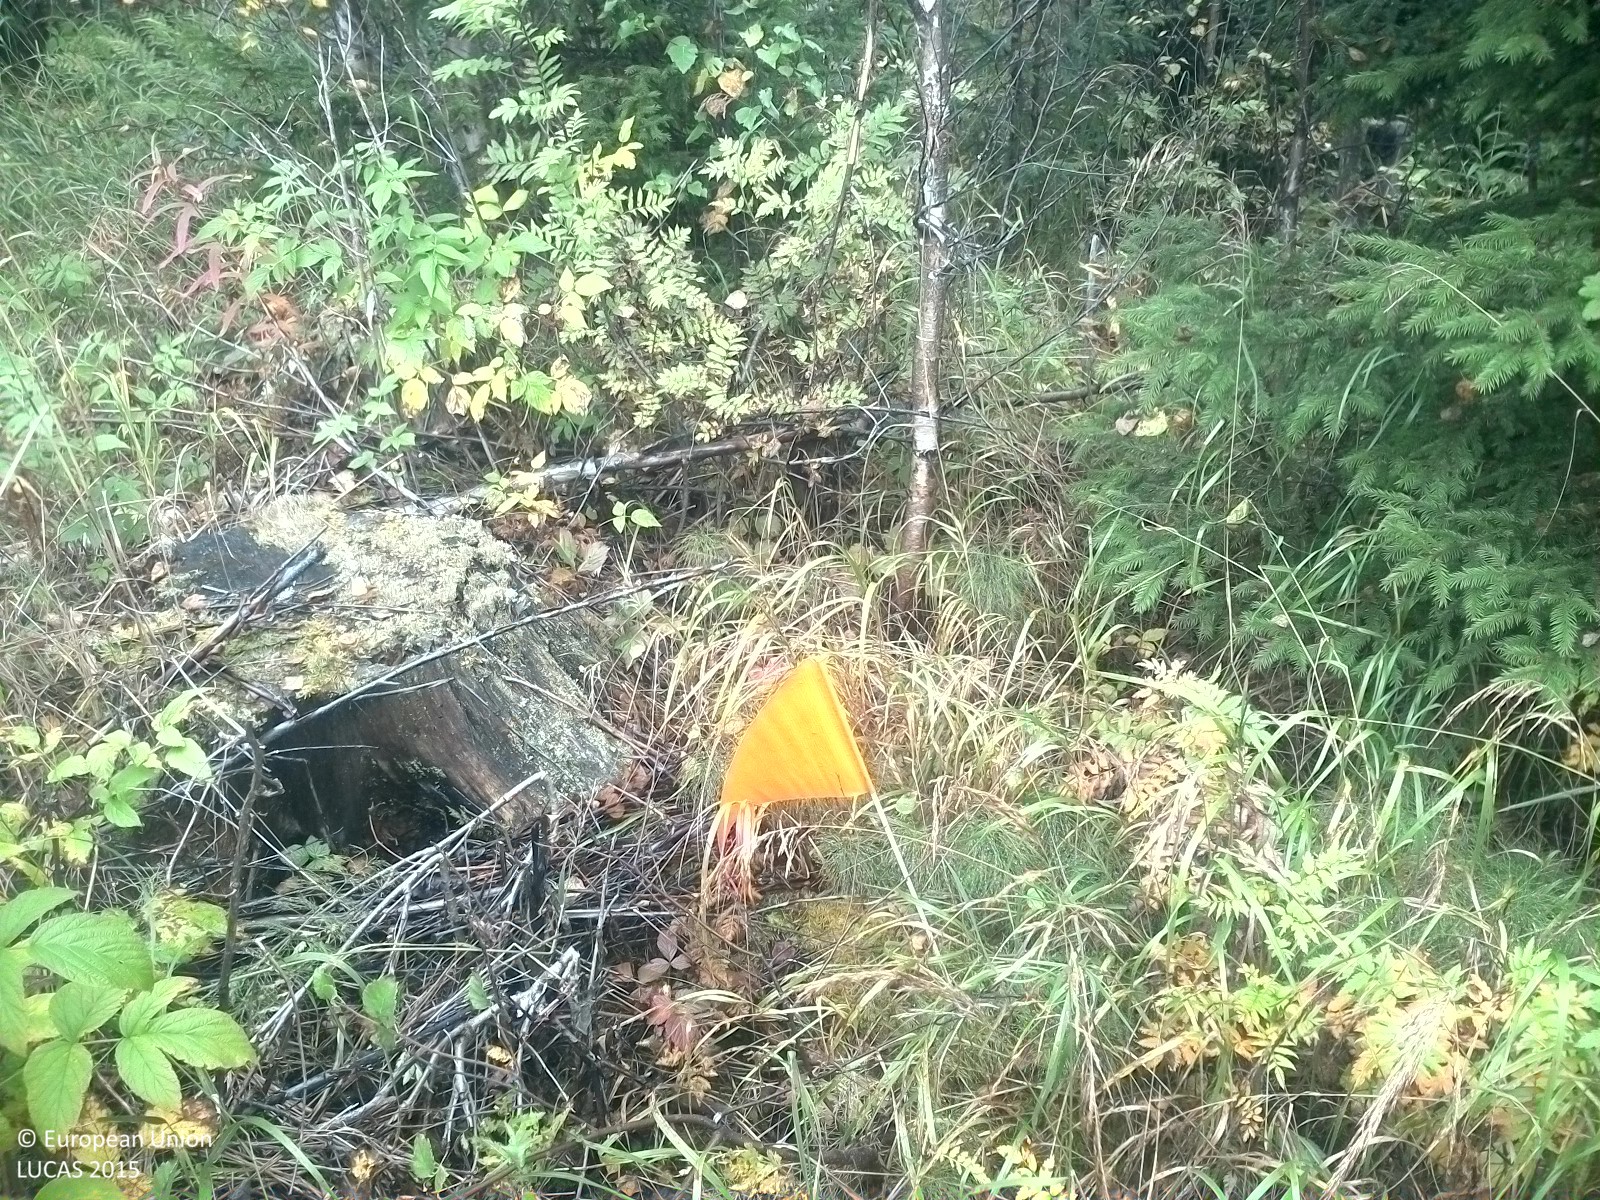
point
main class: Woodland
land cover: Spruce dominated mixed woodland
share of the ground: 25 - 50 %
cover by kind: herbaceous plants 50 %, coniferous forest trees 25 %, shrubs 15 %, broadleaved forest trees 10 %
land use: Forestry
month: September
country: SE
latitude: 62.0898
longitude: 15.6690
